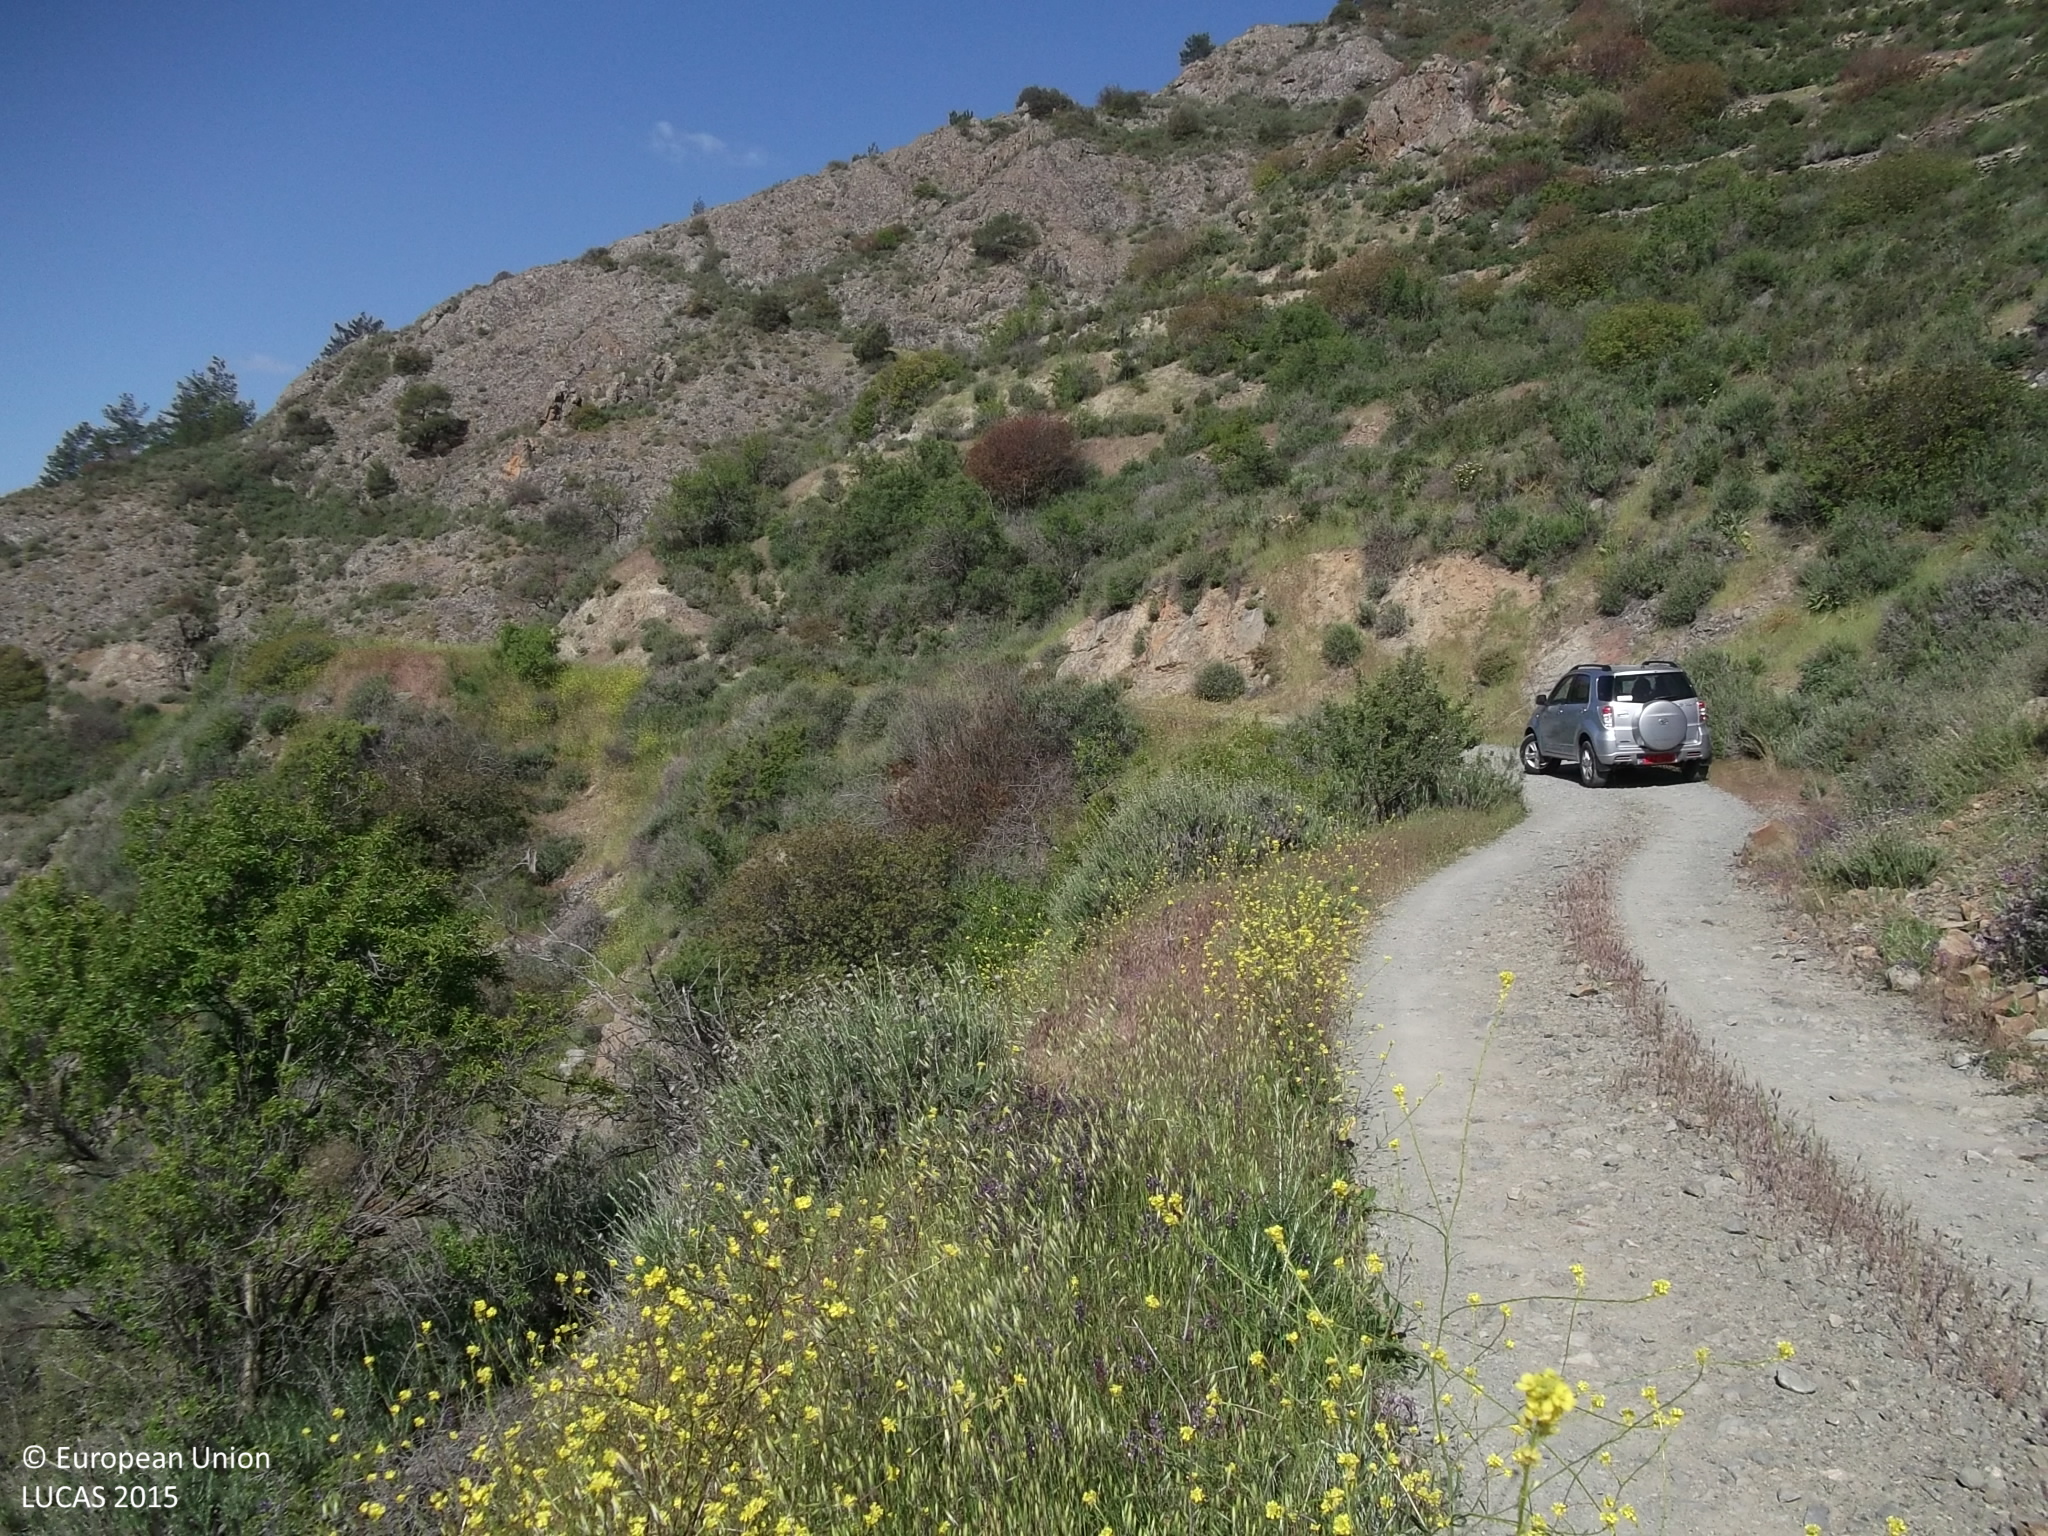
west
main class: Woodland
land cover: Pine dominated mixed woodland
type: coniferous forest of the mediterranean region
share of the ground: 10 - 25 %
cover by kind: shrubs 45 %, unconsolidated bare surface 30 %, coniferous forest trees 15 %, broadleaved forest trees 10 %
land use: Semi-natural and natural areas not in use
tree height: > 5 m
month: April
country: CY
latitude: 34.9341
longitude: 33.1121
